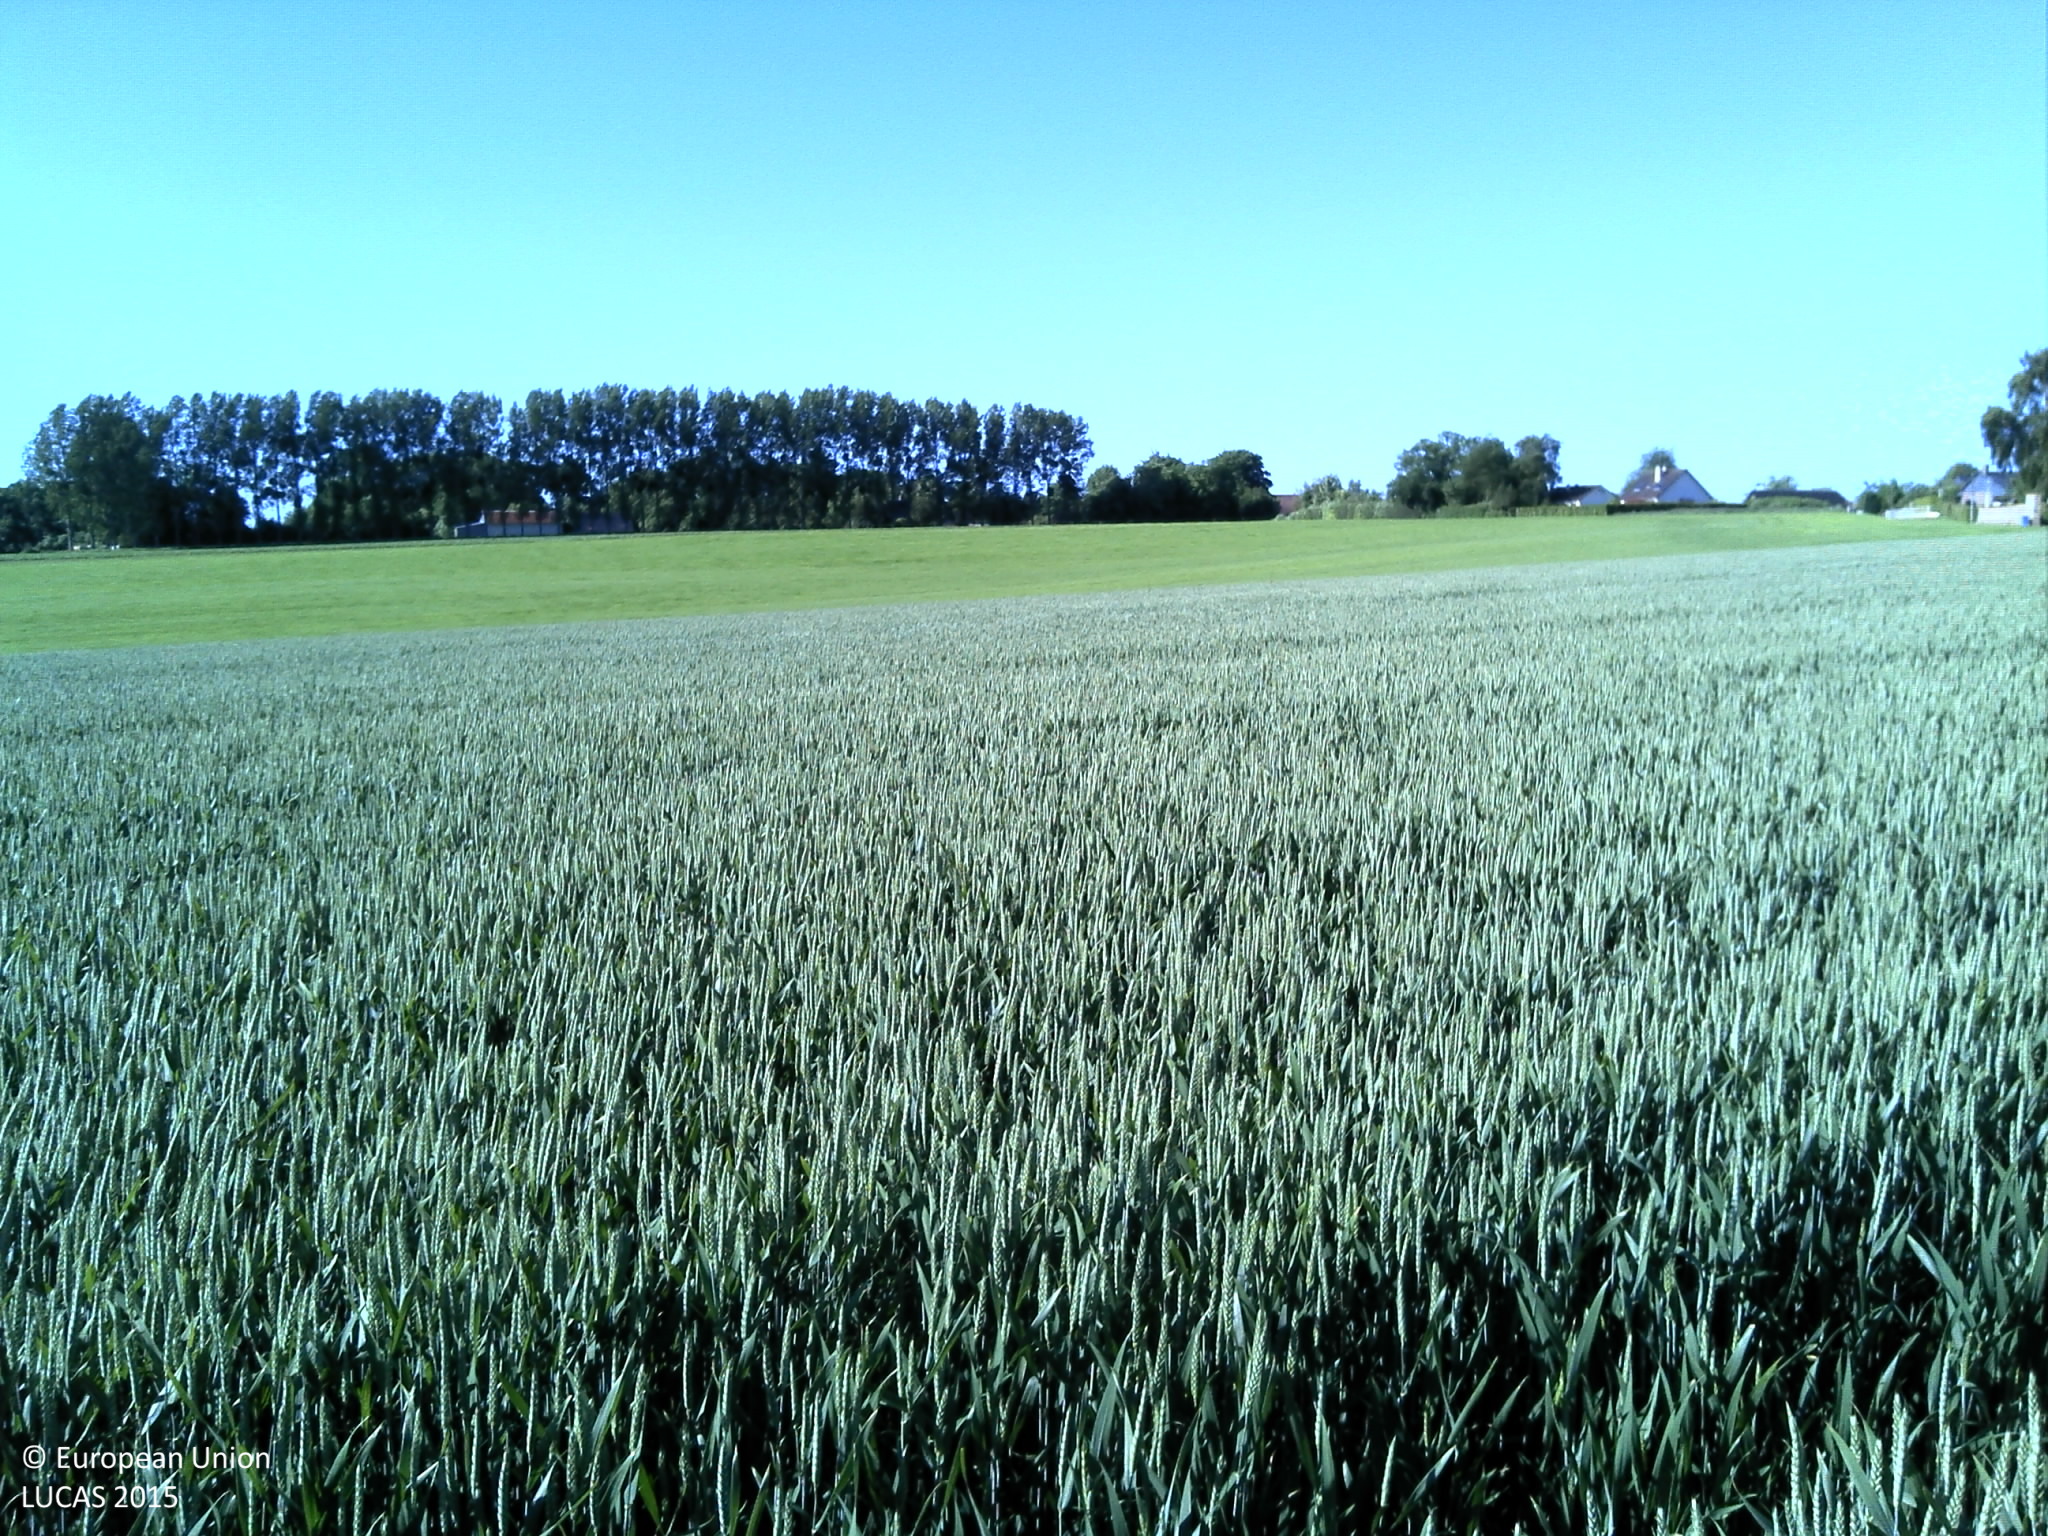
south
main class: Cropland
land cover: Common wheat
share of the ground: > 75 %
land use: Agriculture (excluding fallow land and kitchen gardens)
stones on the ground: < 10 %
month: June
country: FR
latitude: 49.5990
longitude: 1.0817
